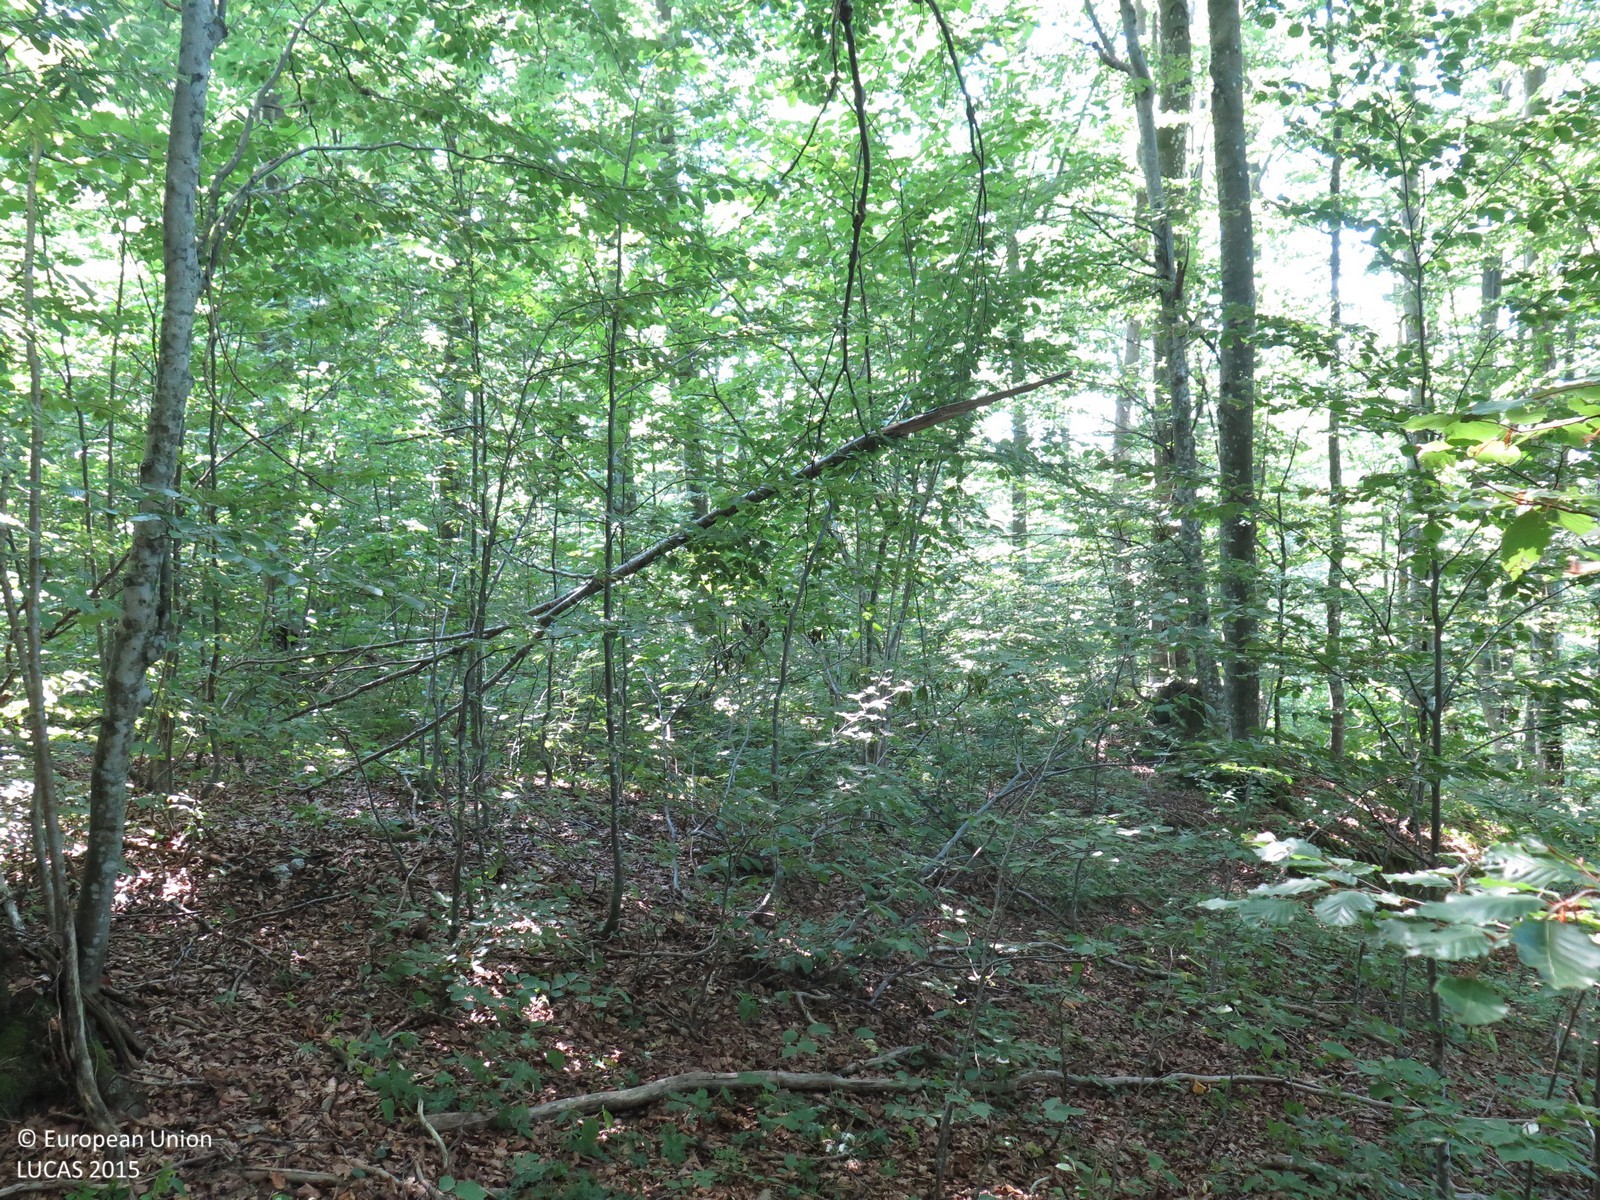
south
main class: Woodland
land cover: Broadleaved woodland
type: beech forest
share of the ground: > 75 %
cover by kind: broadleaved forest trees 95 %, unconsolidated bare surface 5 %
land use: Forestry
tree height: > 5 m
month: August
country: HR
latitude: 45.3745
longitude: 14.8604
